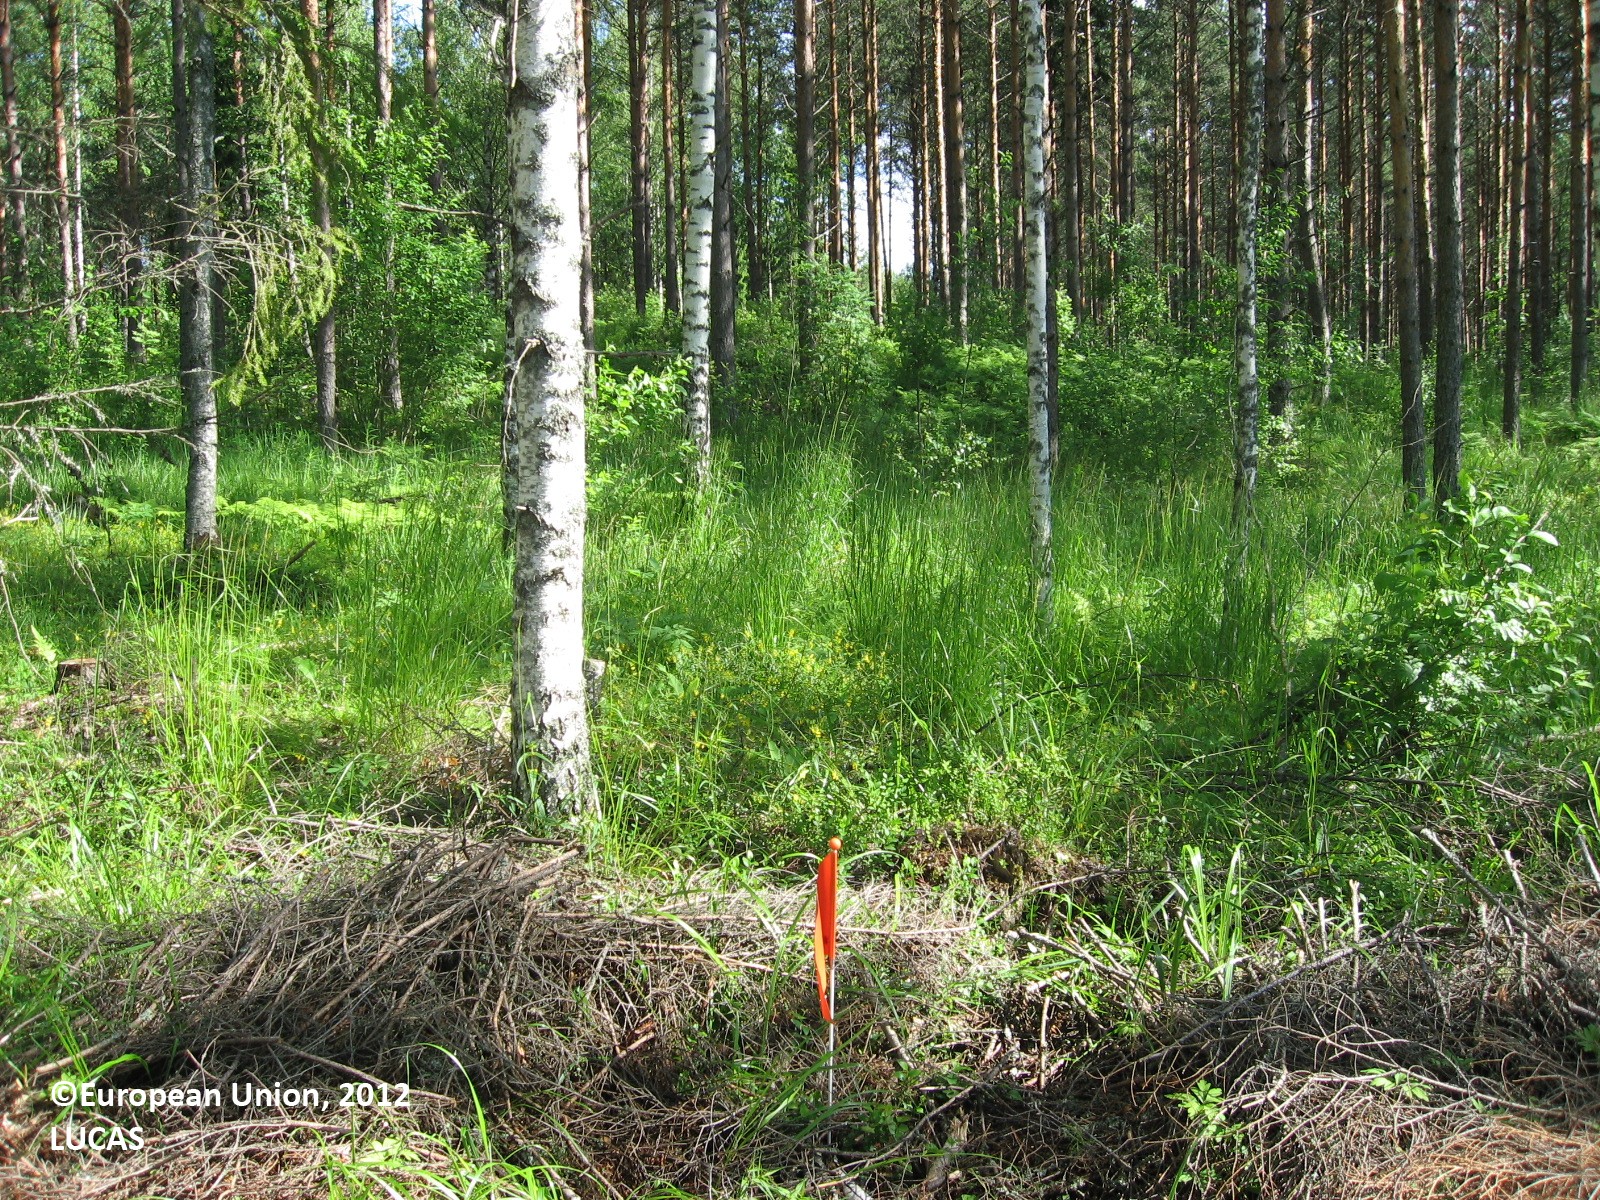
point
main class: Woodland
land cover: Other mixed woodland
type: boreal forest
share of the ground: 25 - 50 %
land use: Forestry
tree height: > 5 m
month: June
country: FI
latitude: 60.6835
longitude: 26.4293
